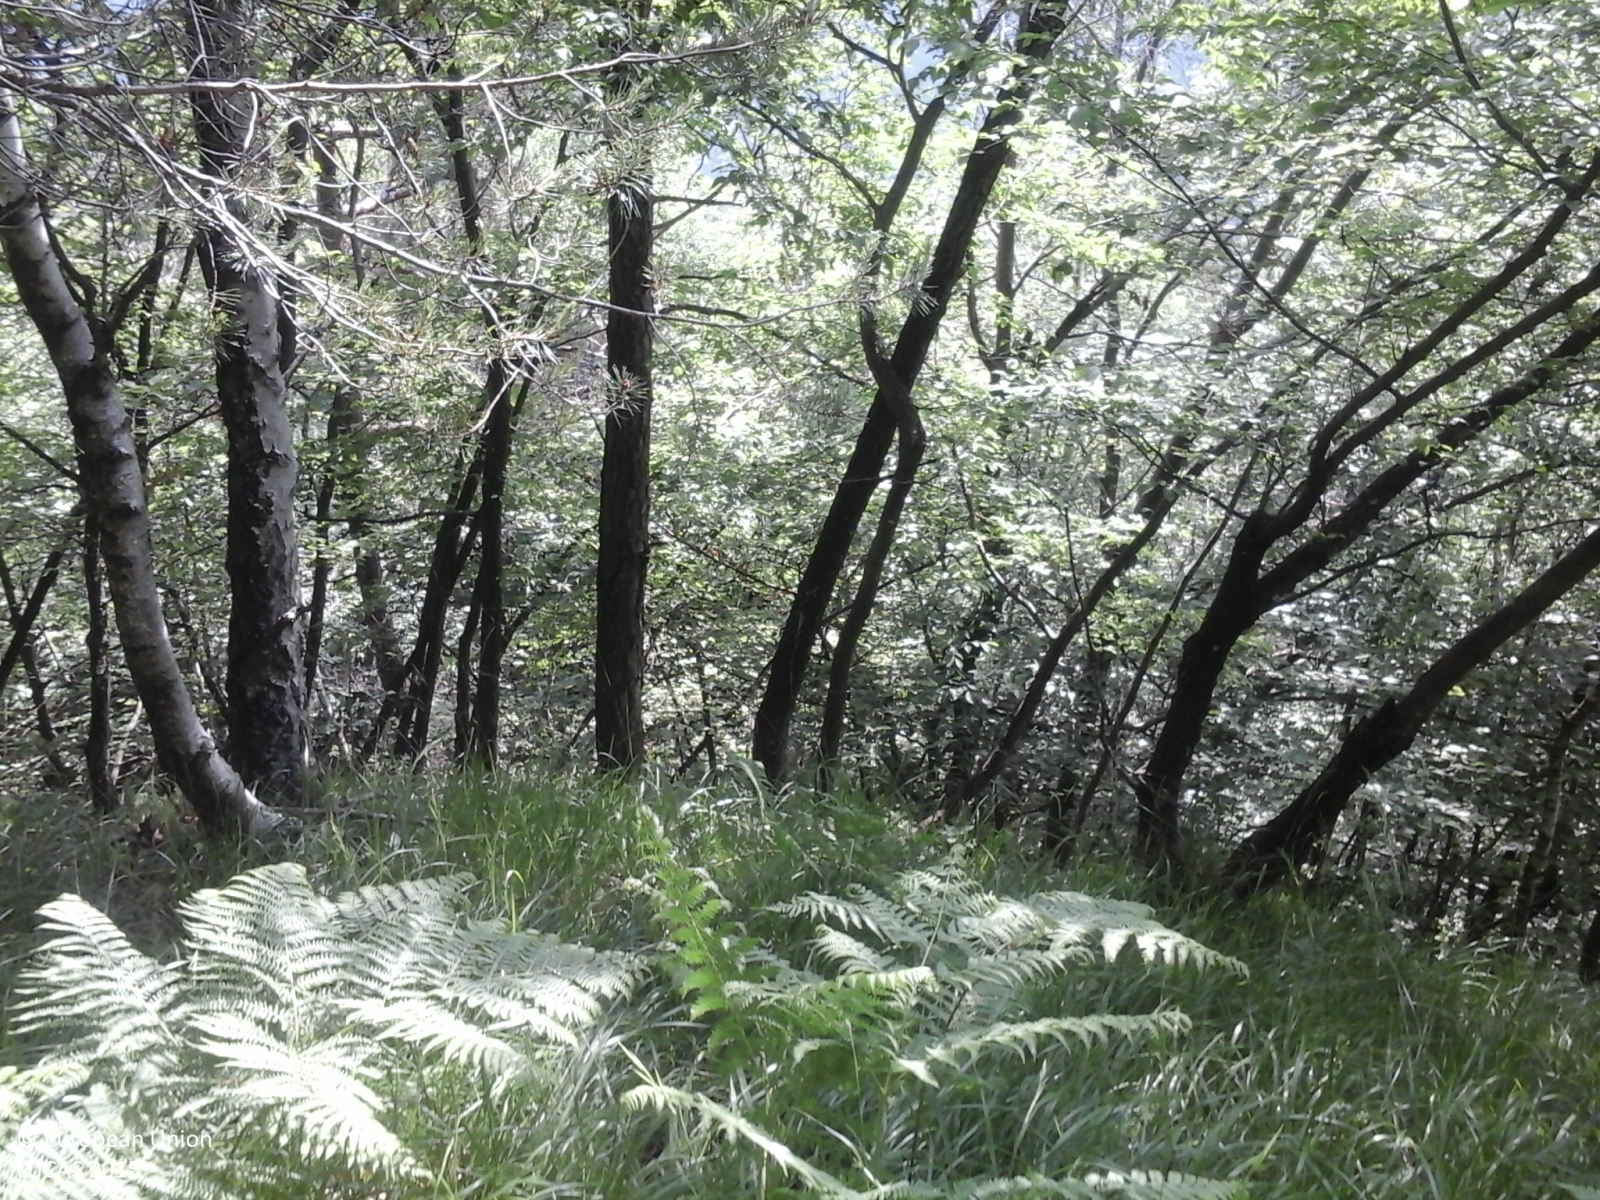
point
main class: Woodland
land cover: Other mixed woodland
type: thermophilous deciduous forest
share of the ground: > 75 %
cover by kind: coniferous forest trees 50 %, broadleaved forest trees 50 %
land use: Semi-natural and natural areas not in use
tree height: > 5 m
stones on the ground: < 10 %
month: June
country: IT
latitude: 46.3440
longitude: 12.3231
